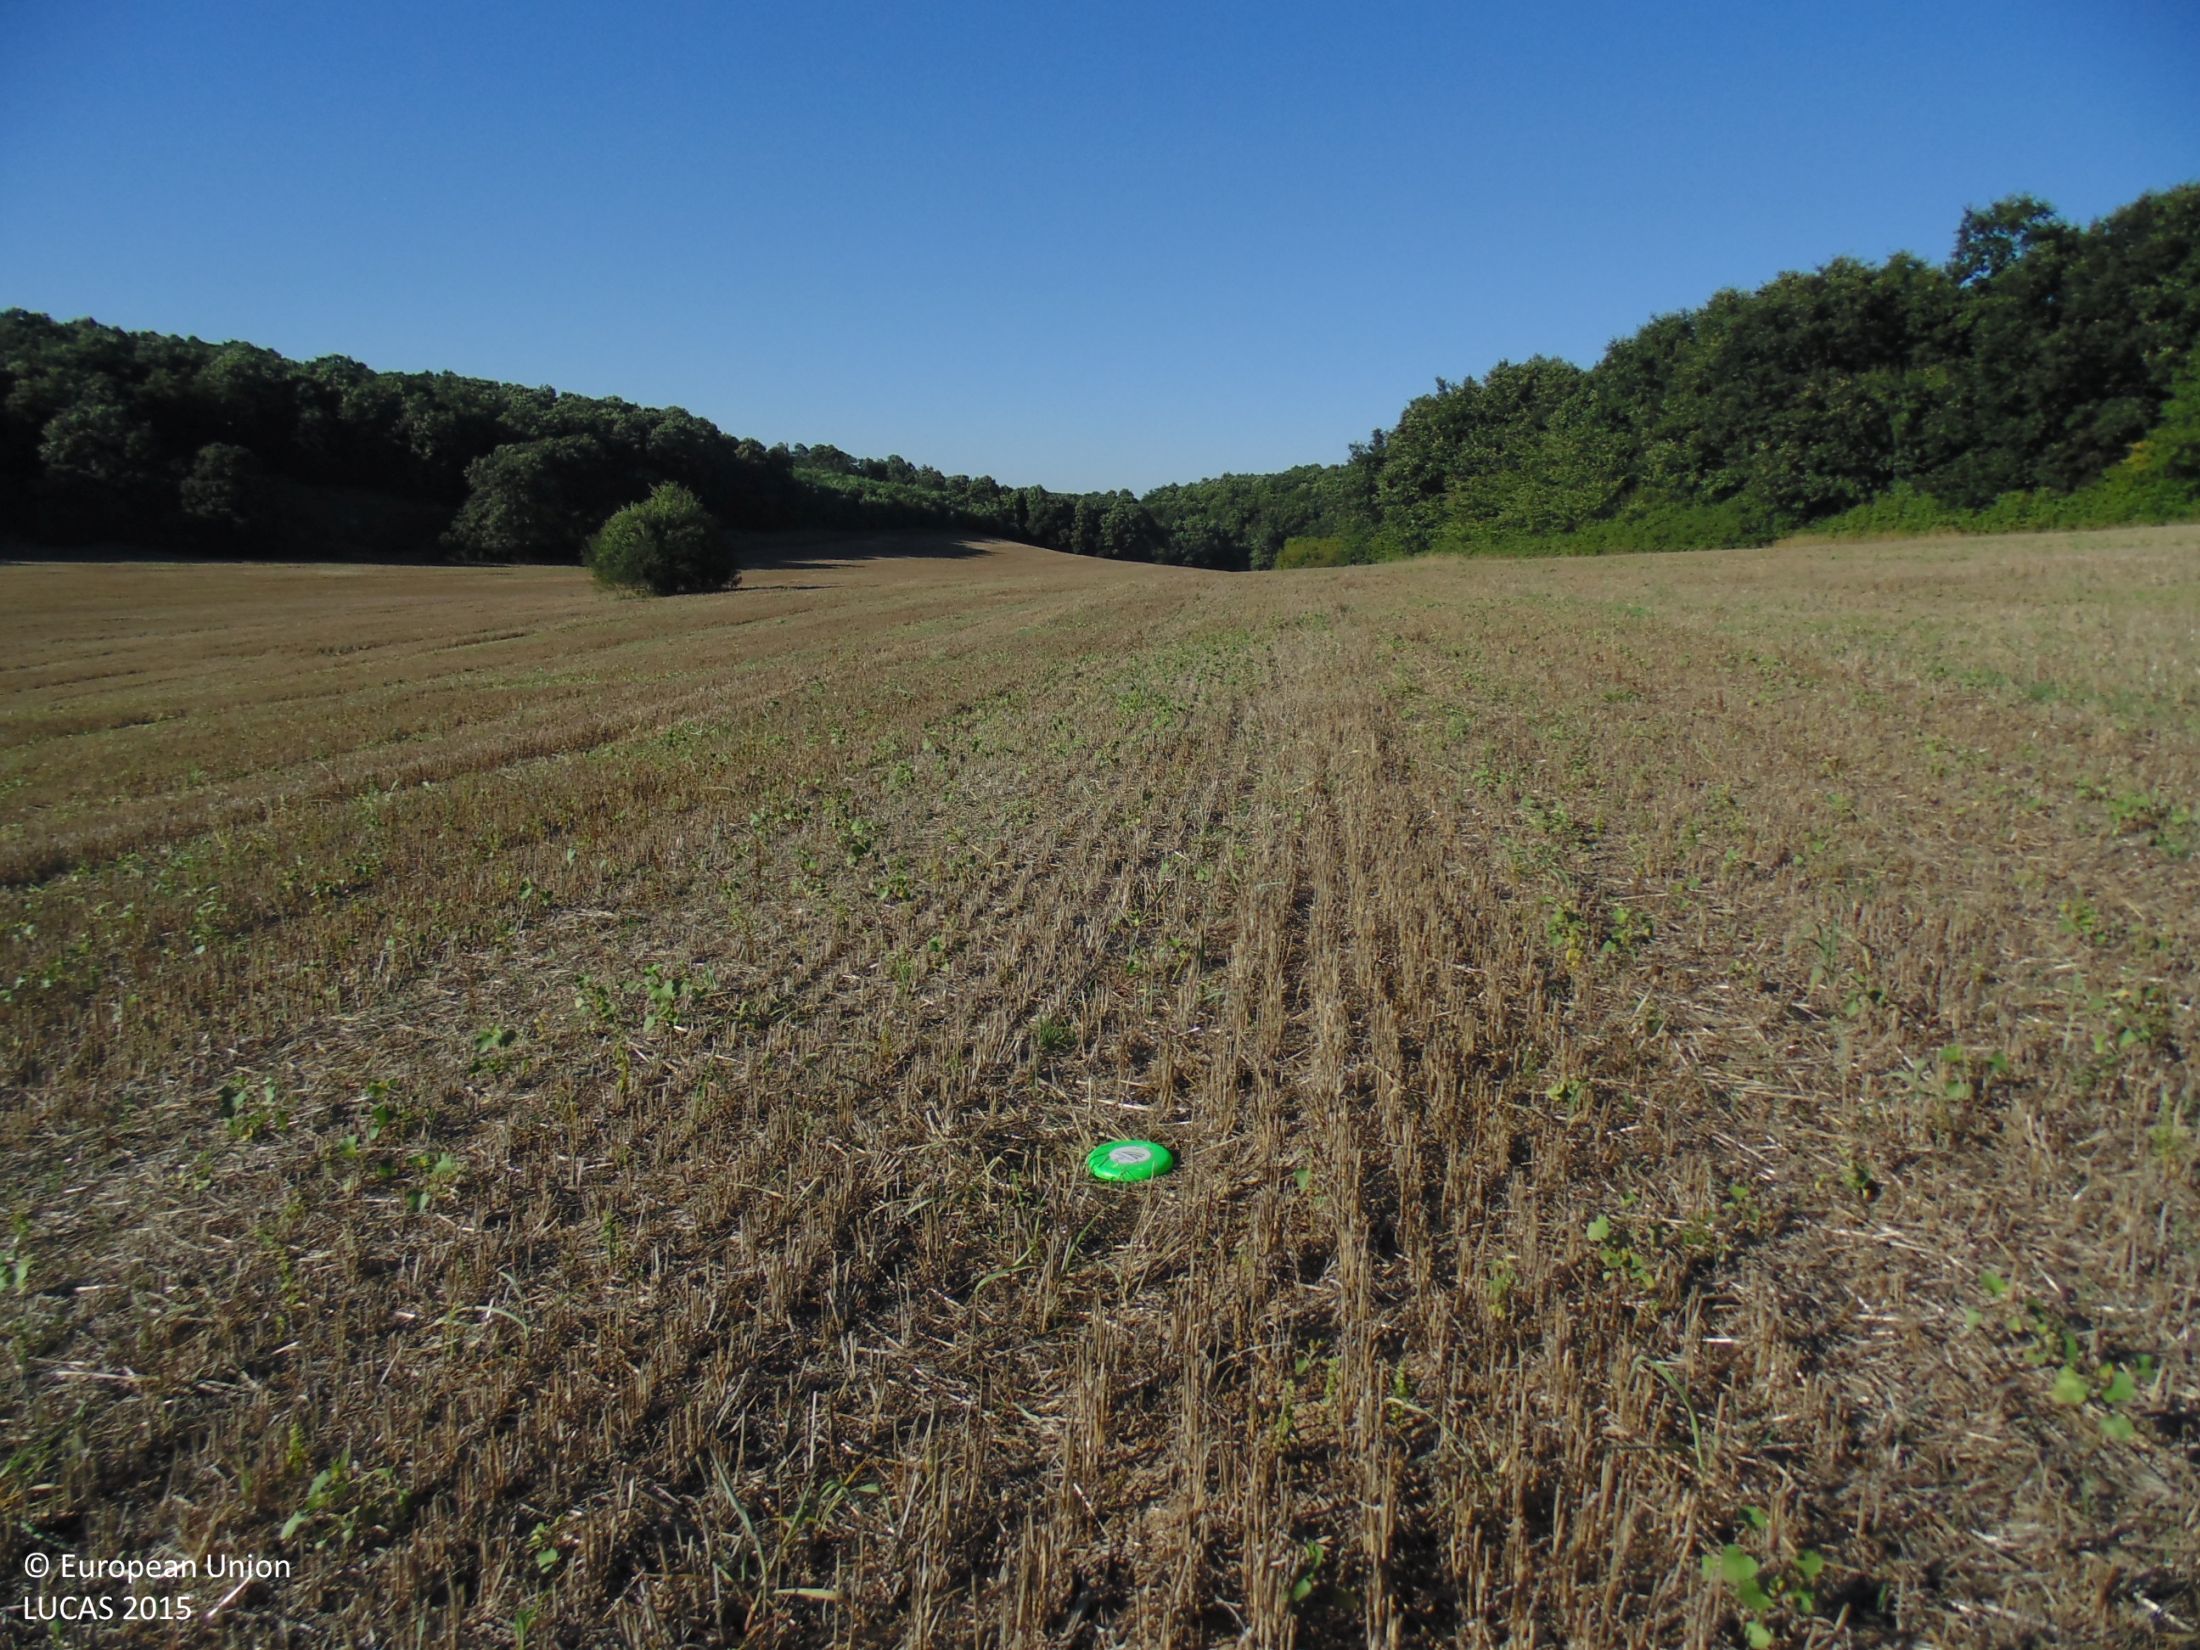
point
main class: Cropland
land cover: Common wheat
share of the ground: 25 - 50 %
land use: Agriculture (excluding fallow land and kitchen gardens)
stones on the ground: < 10 %
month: September
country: BG
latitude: 43.8004
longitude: 27.2171
